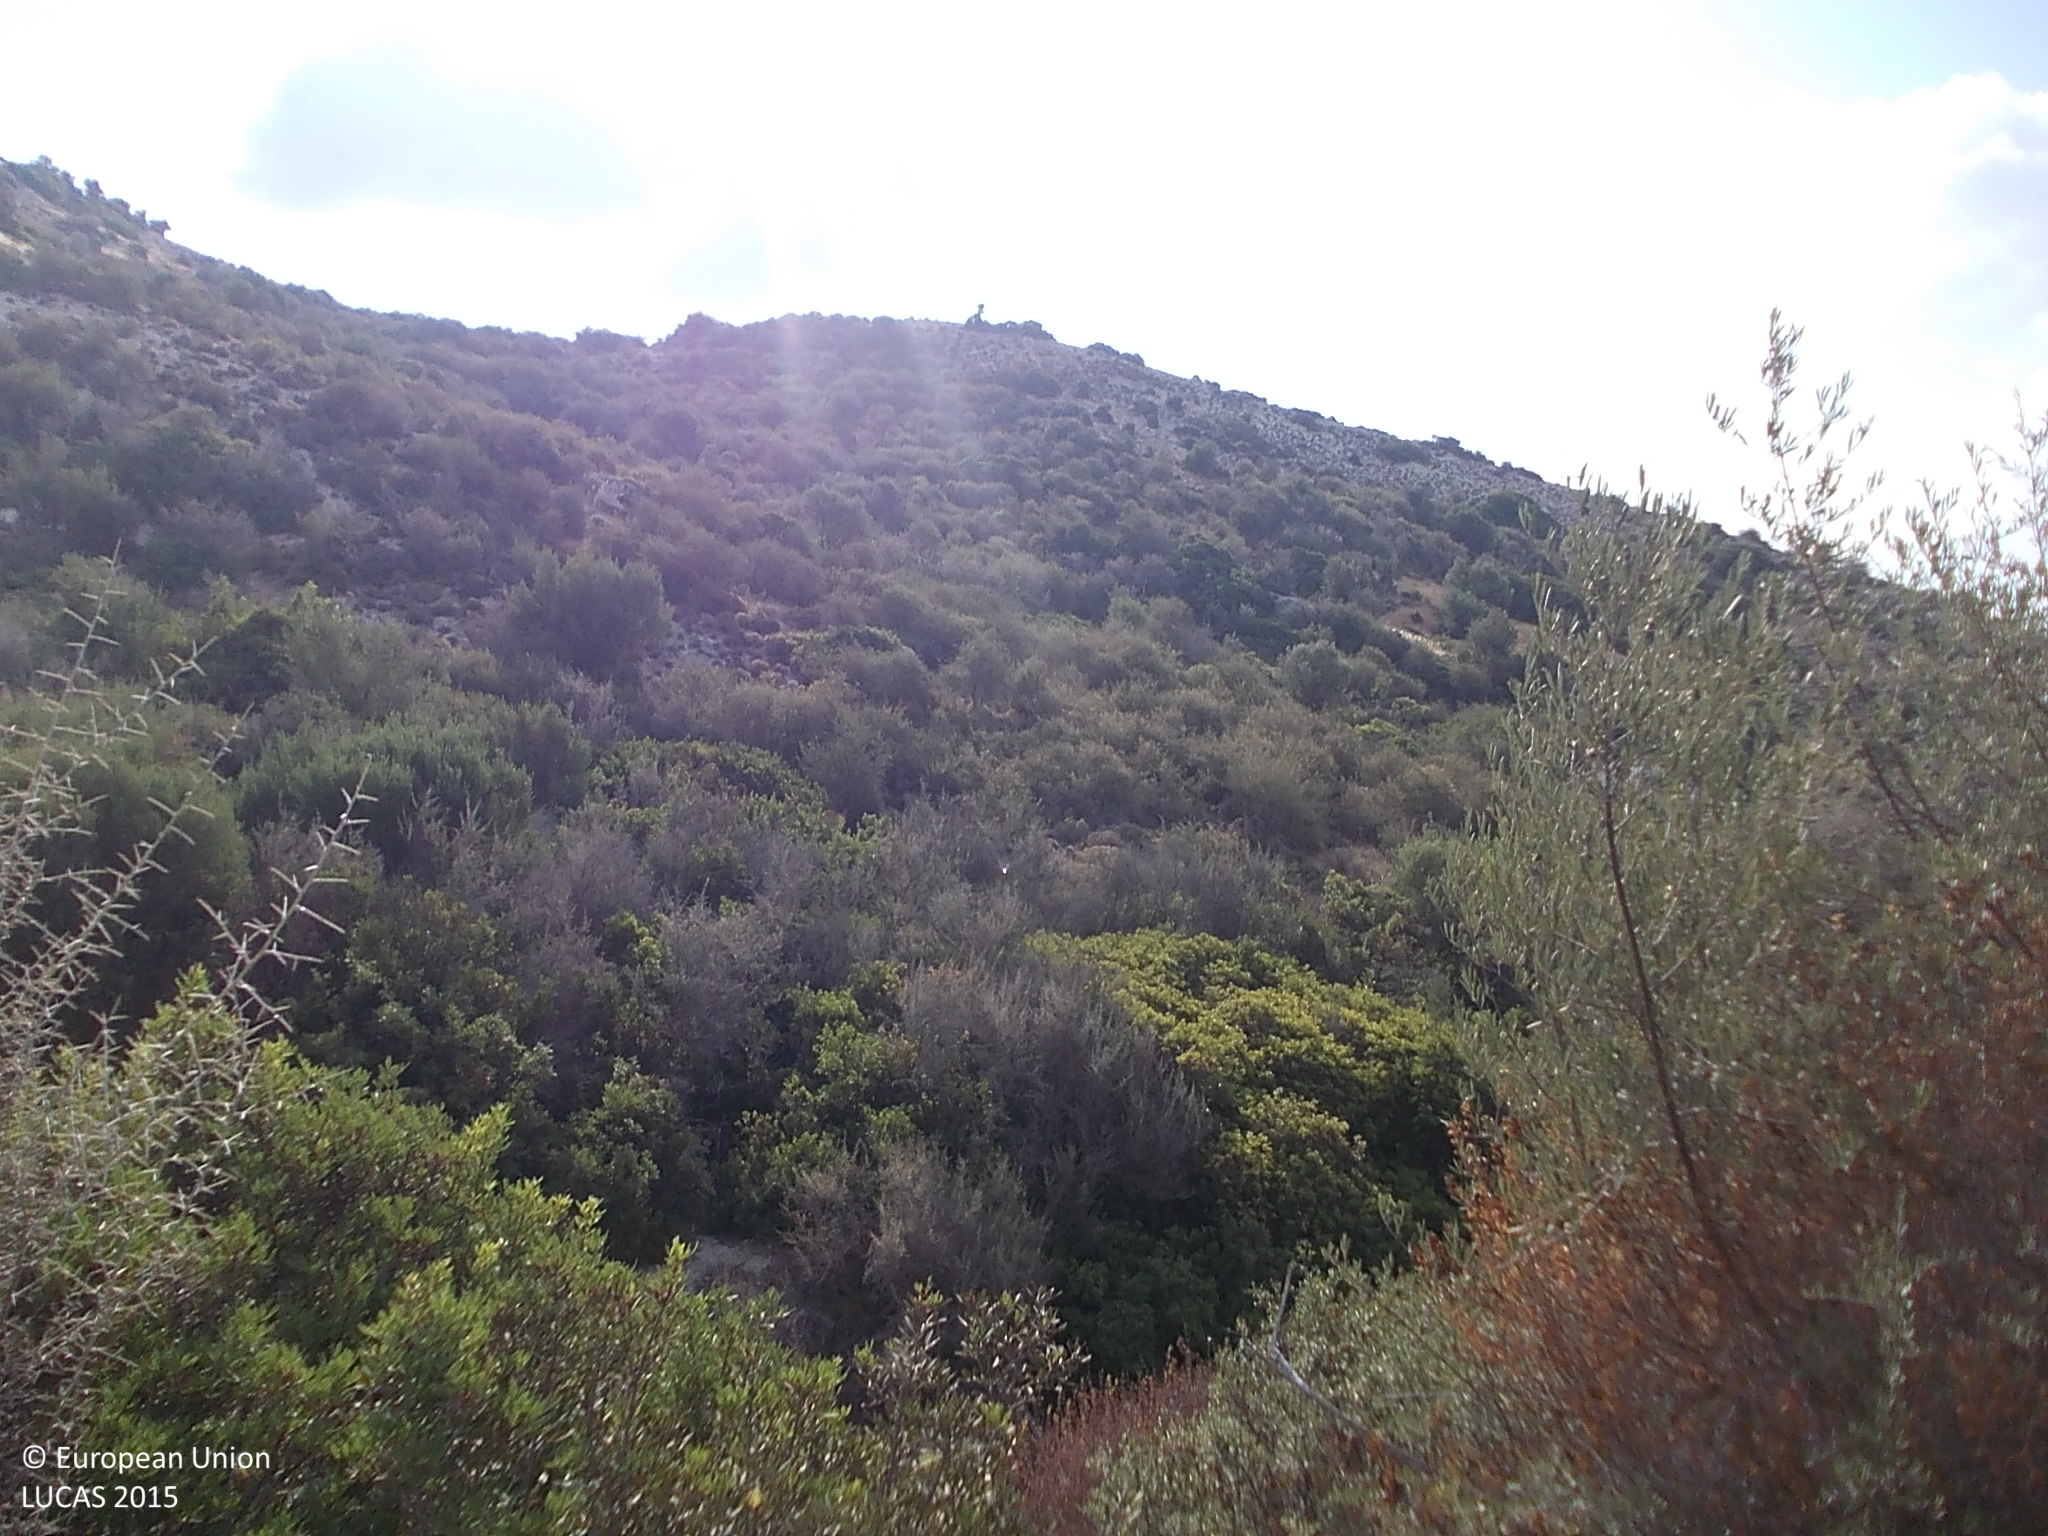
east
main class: Shrubland
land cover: Shrubland with sparse tree cover
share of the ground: > 75 %
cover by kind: shrubs 75 %, herbaceous plants 10 %, unconsolidated bare surface 10 %, broadleaved forest trees 5 %
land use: Semi-natural and natural areas not in use
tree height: < 5 m
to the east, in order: Shrubland with sparse tree cover; Shrubland without tree cover; Rivers and streams; Shrubland without tree cover; Rivers and streams; Shrubland without tree cover
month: August
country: CY
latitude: 34.6970
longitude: 32.7177
